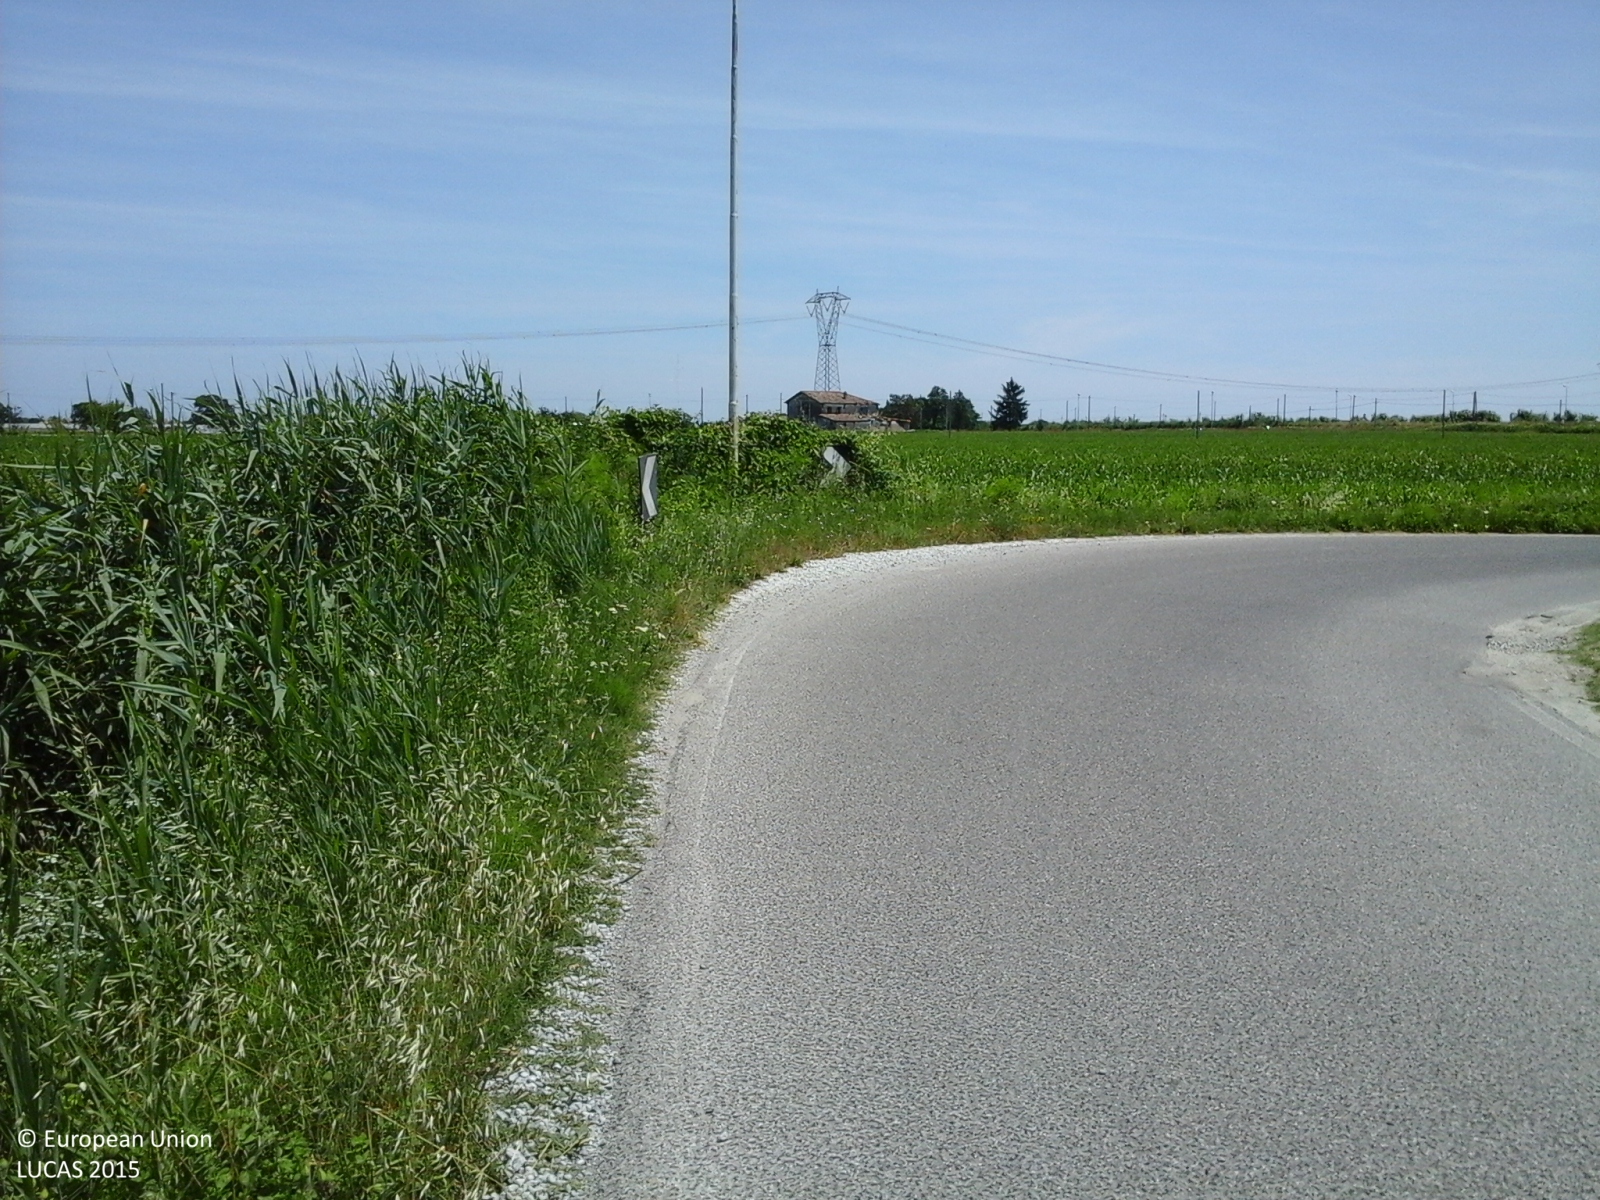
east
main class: Cropland
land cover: Lucerne
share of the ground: > 75 %
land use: Agriculture (excluding fallow land and kitchen gardens)
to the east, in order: Lucerne; Grass margins; Ditches and canals; Grass margins; Other cereals; Ditches and canals; Other cereals; Ditches and canals; Other cereals; Ditches and canals; Other cereals; Ditches and canals; Other cereals; Electric lines; Other cereals; Ditches and canals; Other cereals; Ditches and canals; Other cereals
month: June
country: IT
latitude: 44.1614
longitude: 12.3581
